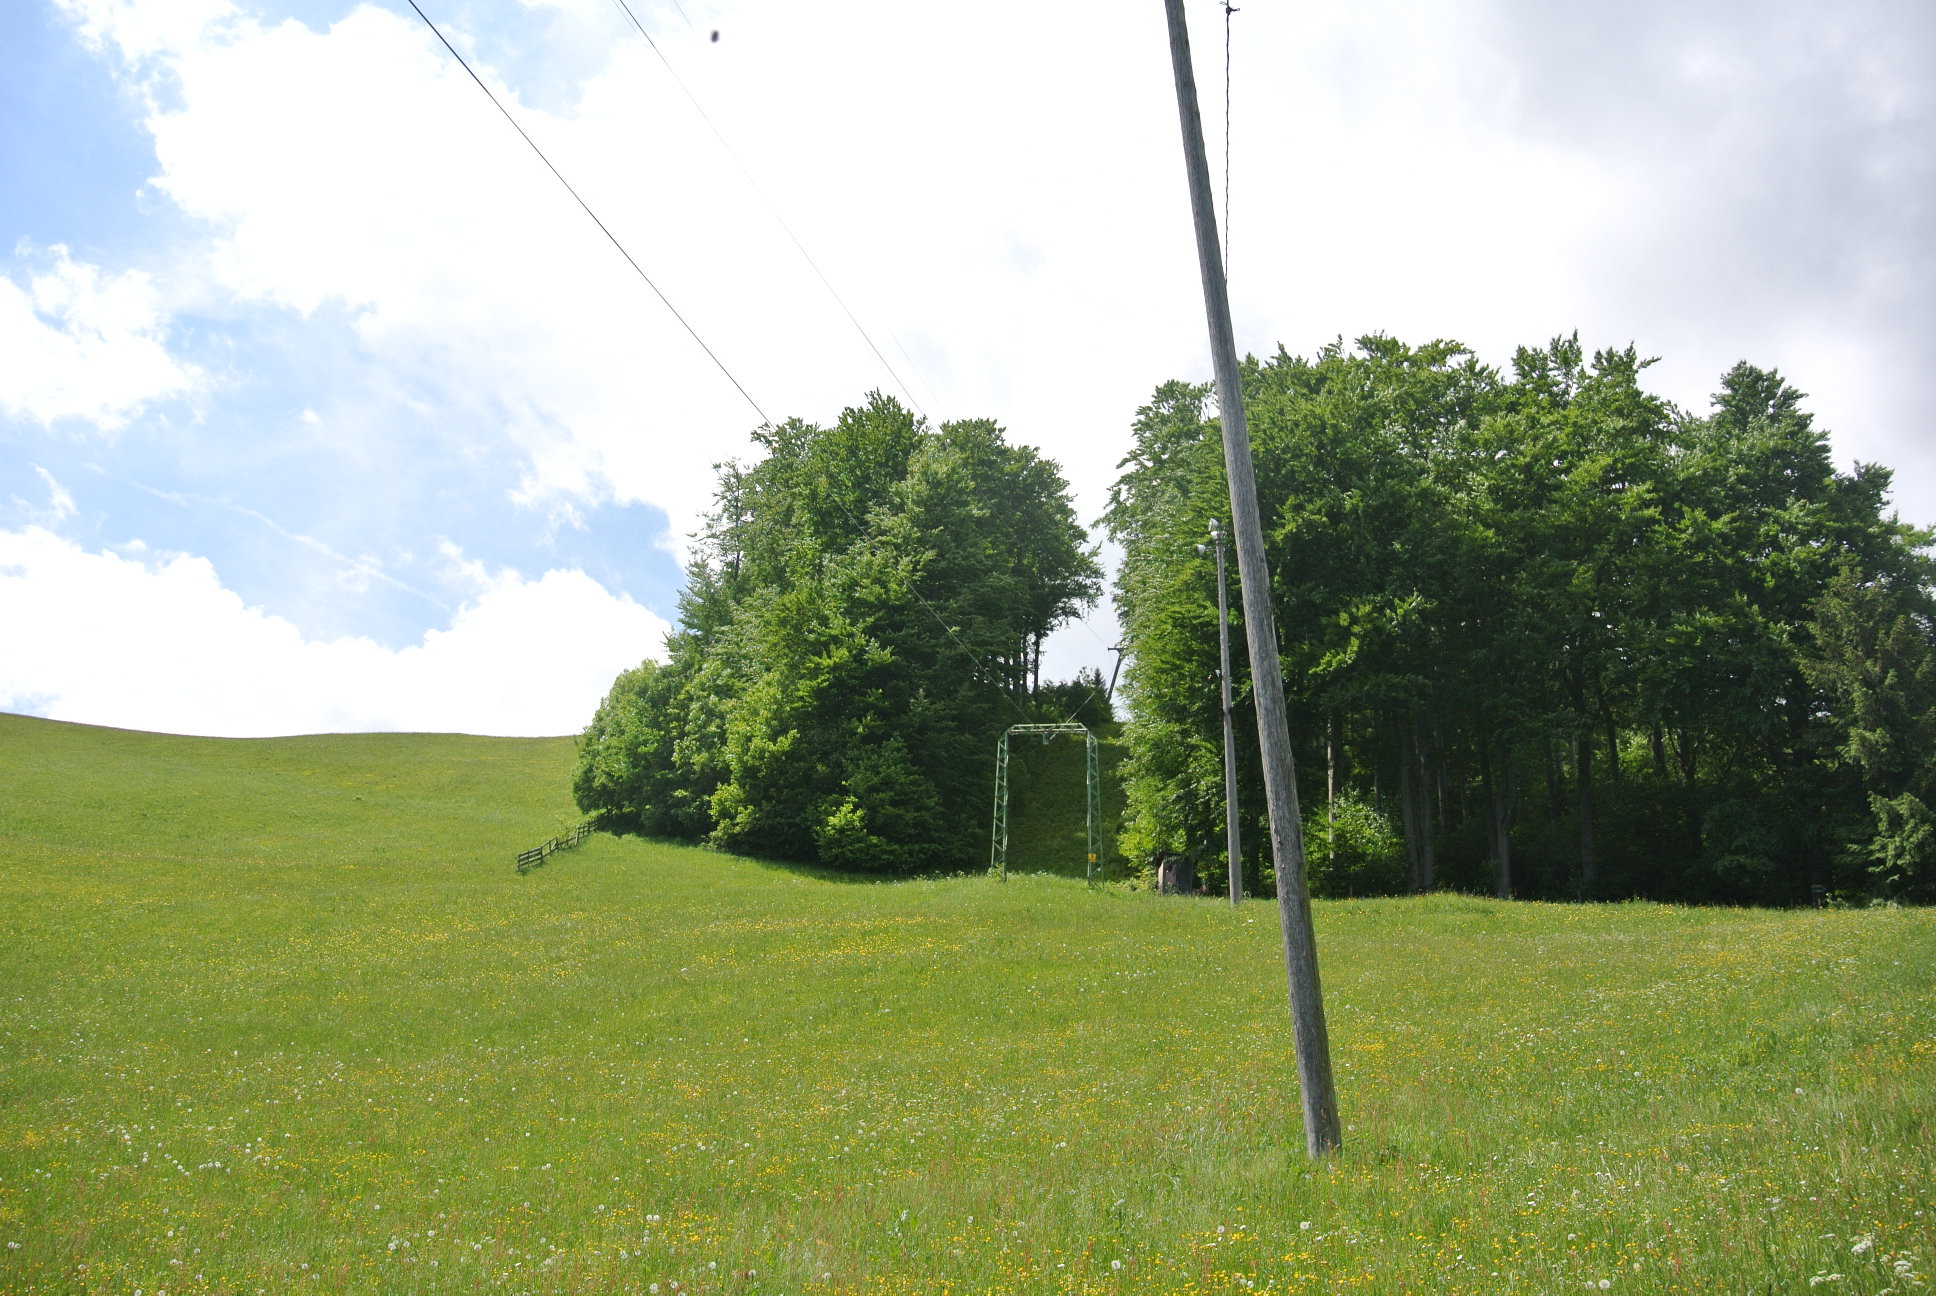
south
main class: Grassland
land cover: Grassland without tree/shrub cover
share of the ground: > 75 %
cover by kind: herbaceous plants 100 %
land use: Agriculture (excluding fallow land and kitchen gardens)
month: May
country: AT
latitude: 47.9998
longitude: 15.7792
